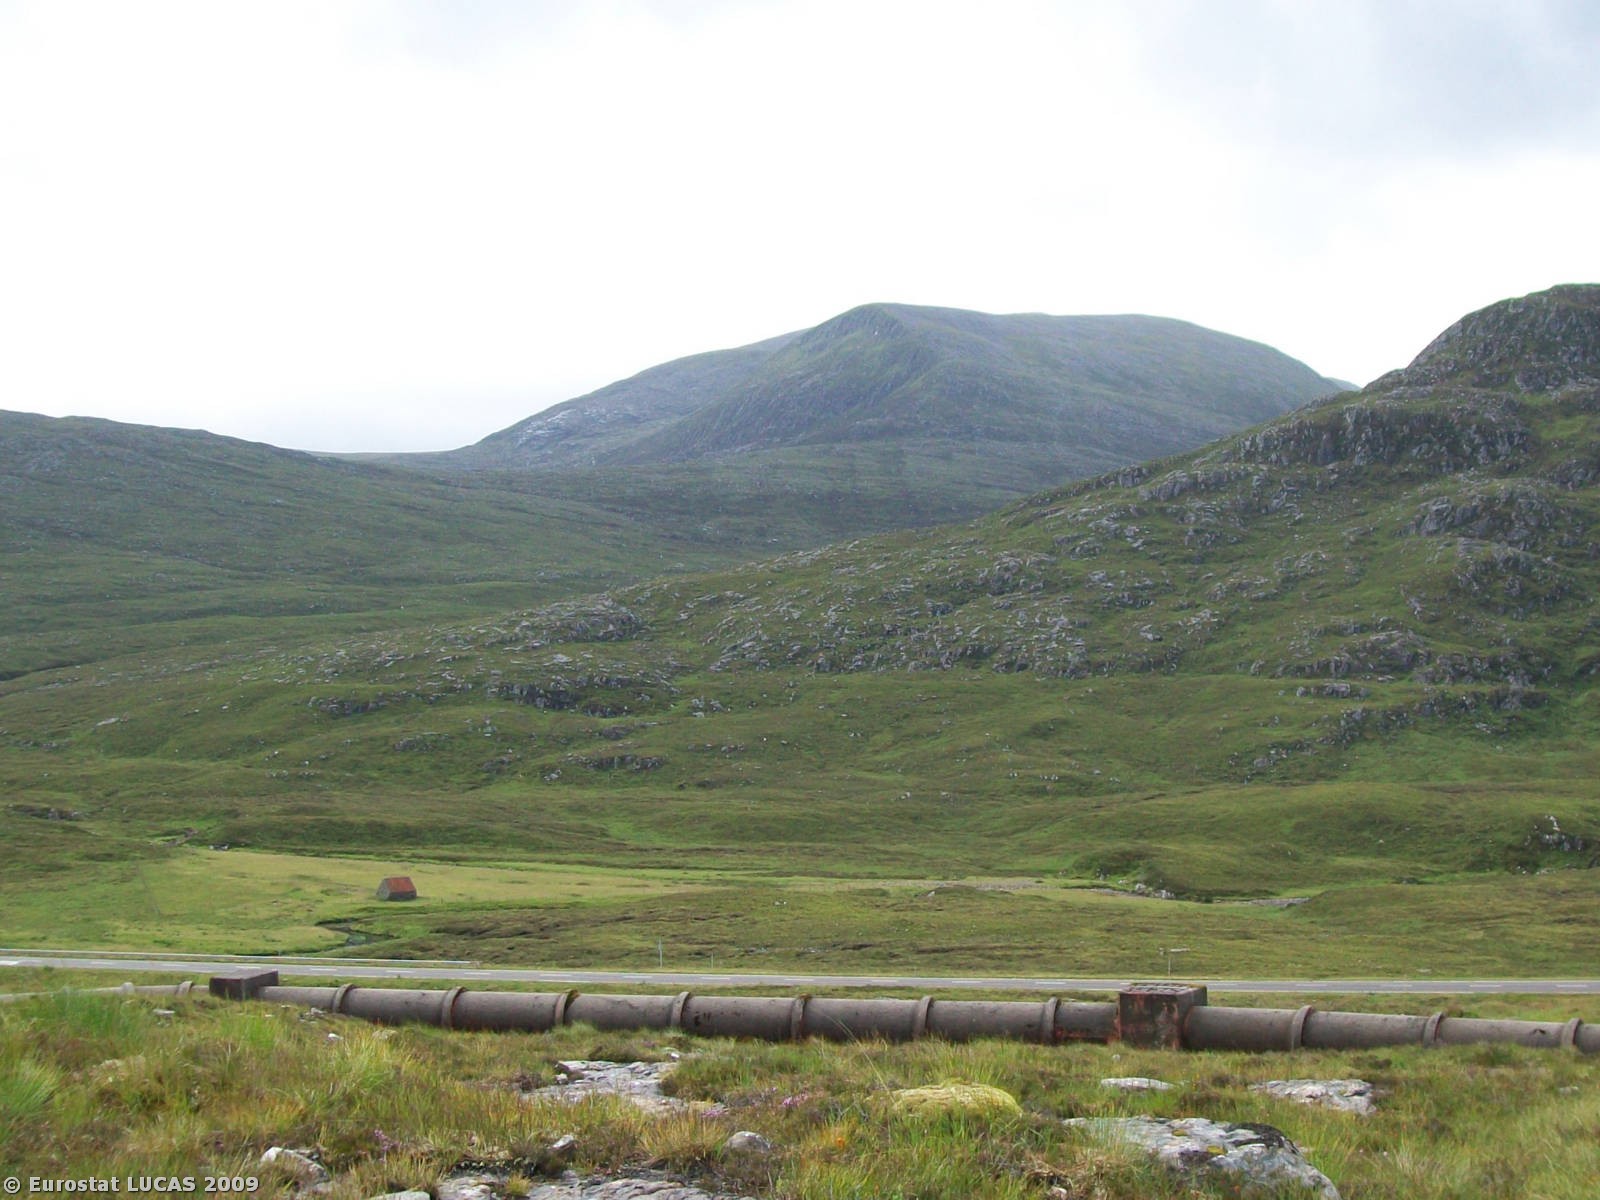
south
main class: Shrubland
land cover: Shrubland without tree cover
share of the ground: > 75 %
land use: Transport via pipelines
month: July
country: GB
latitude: 57.7413
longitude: -4.9669
